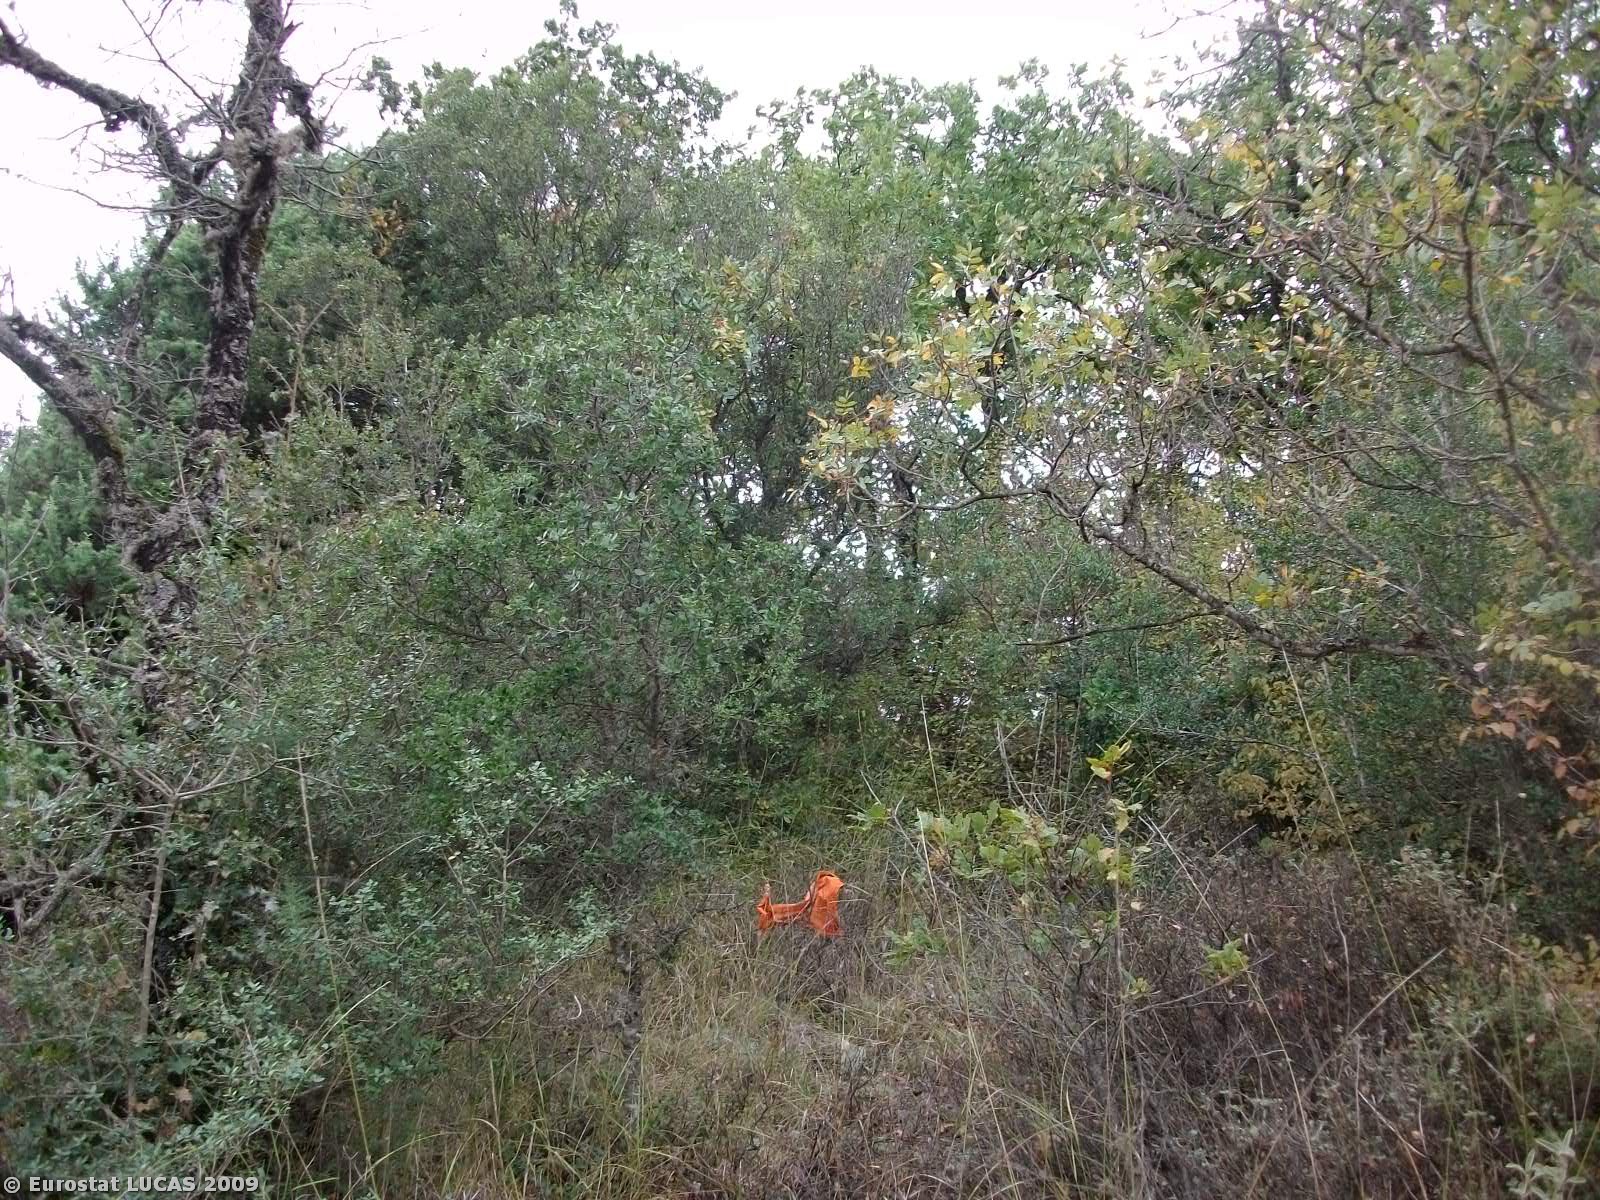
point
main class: Shrubland
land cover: Shrubland with sparse tree cover
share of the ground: > 75 %
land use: Unused
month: October
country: GR
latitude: 39.8955
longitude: 20.3990
